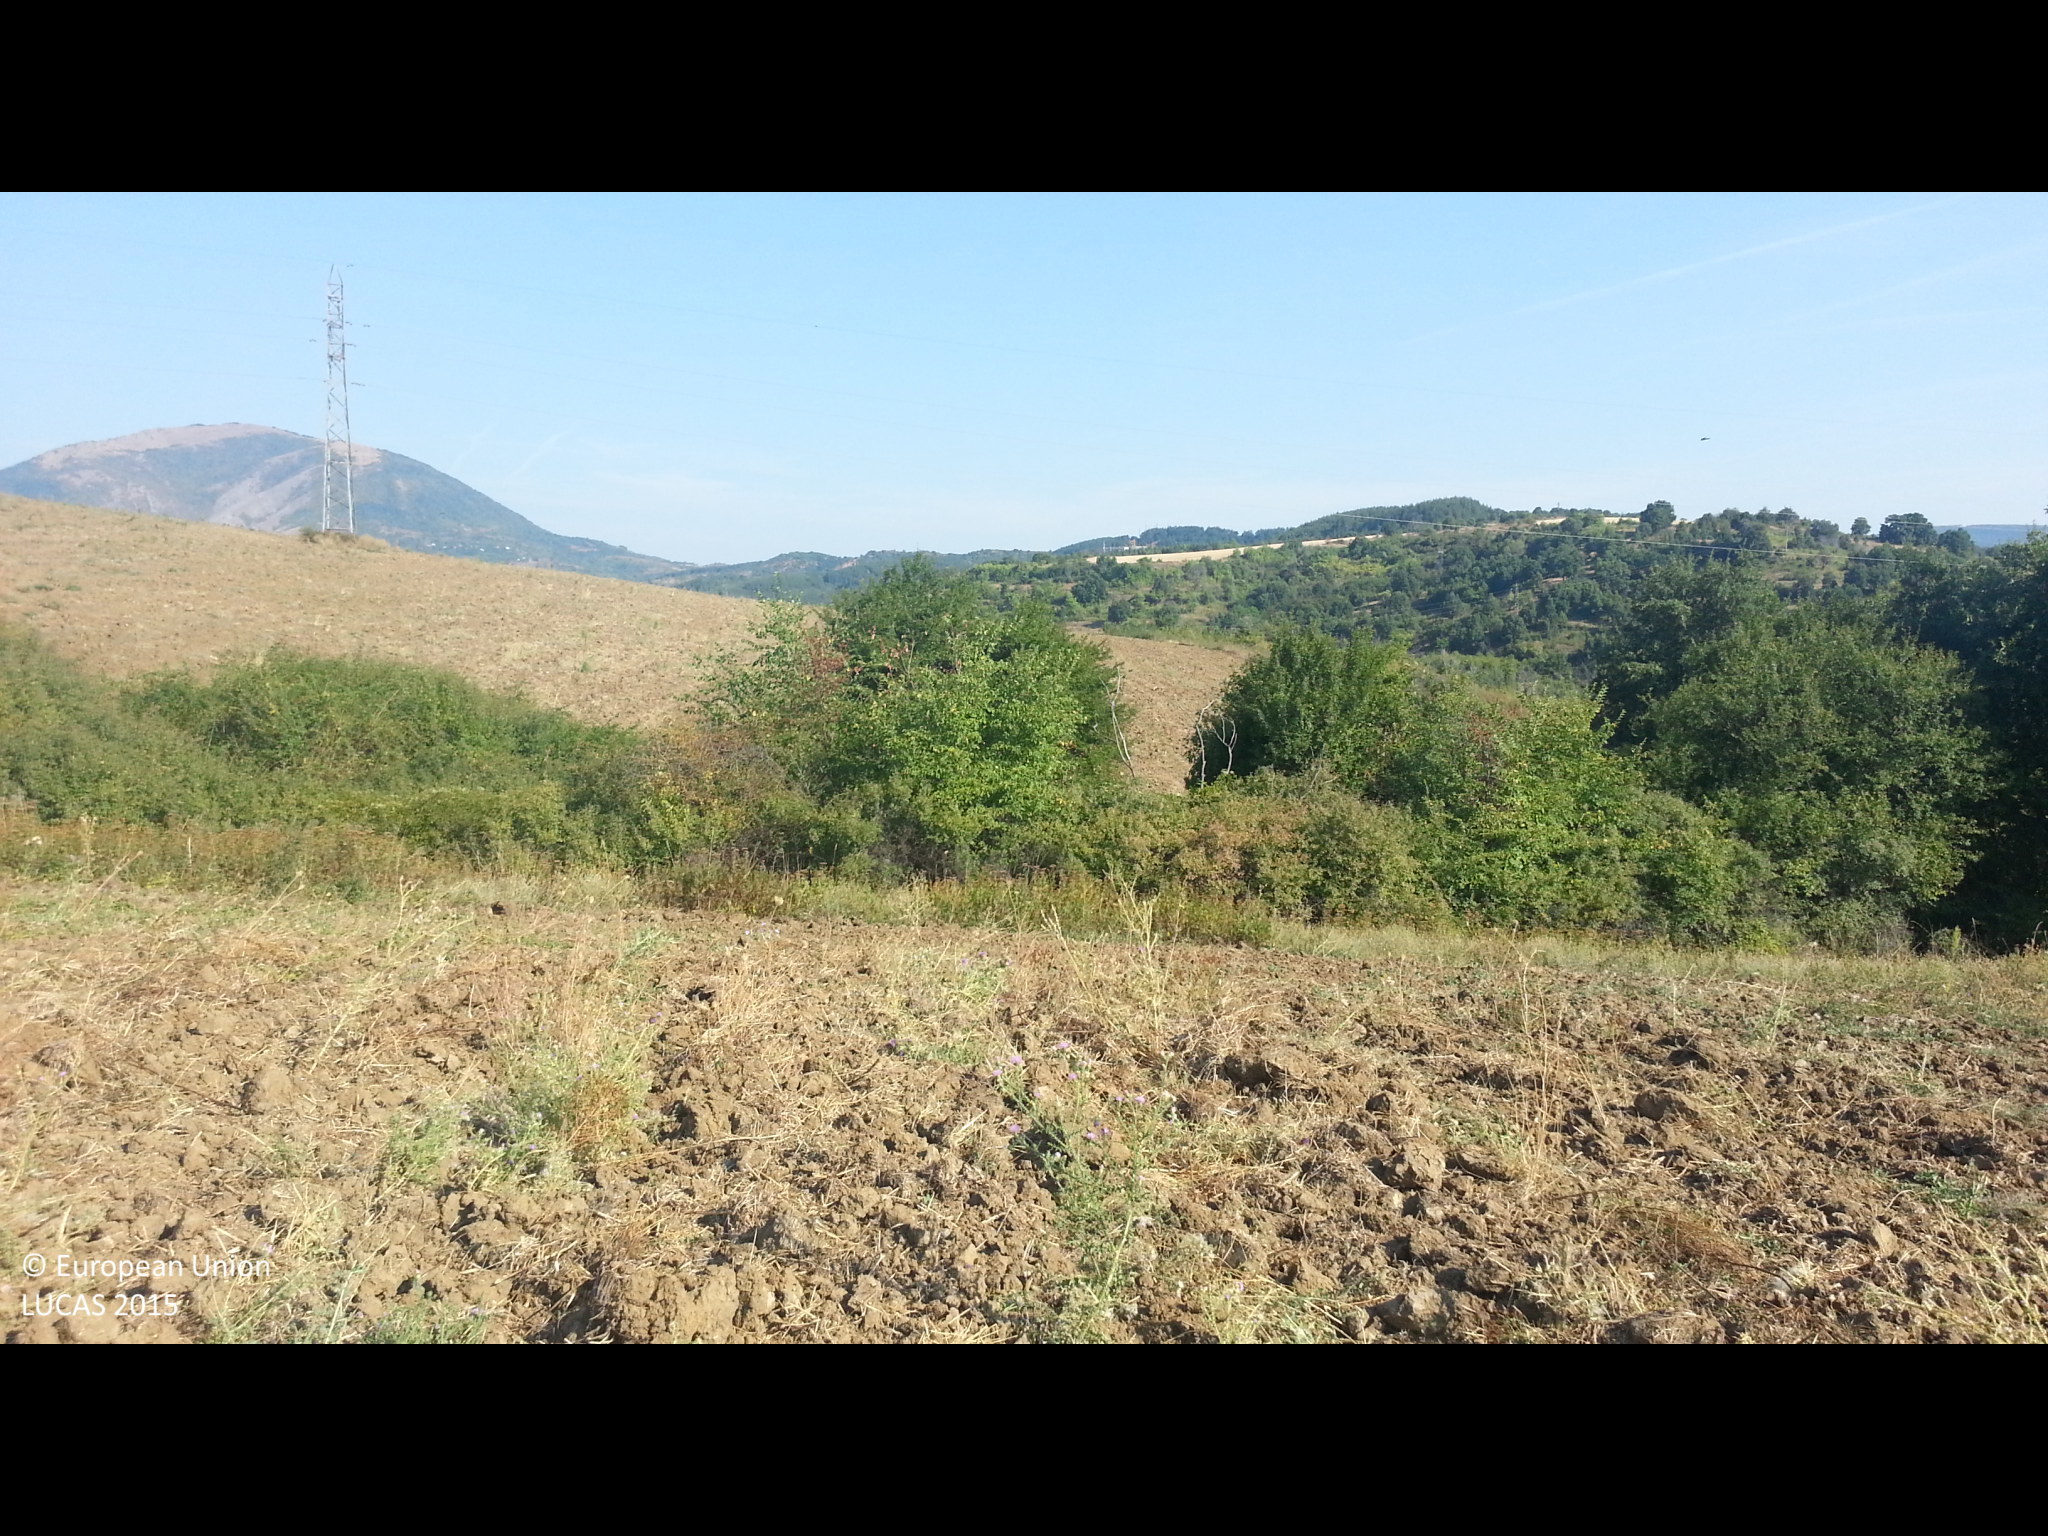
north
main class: Cropland
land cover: Common wheat
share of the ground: < 10 %
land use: Agriculture (excluding fallow land and kitchen gardens)
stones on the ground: 10 - 25 %
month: September
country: BG
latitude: 42.3449
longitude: 22.9779
